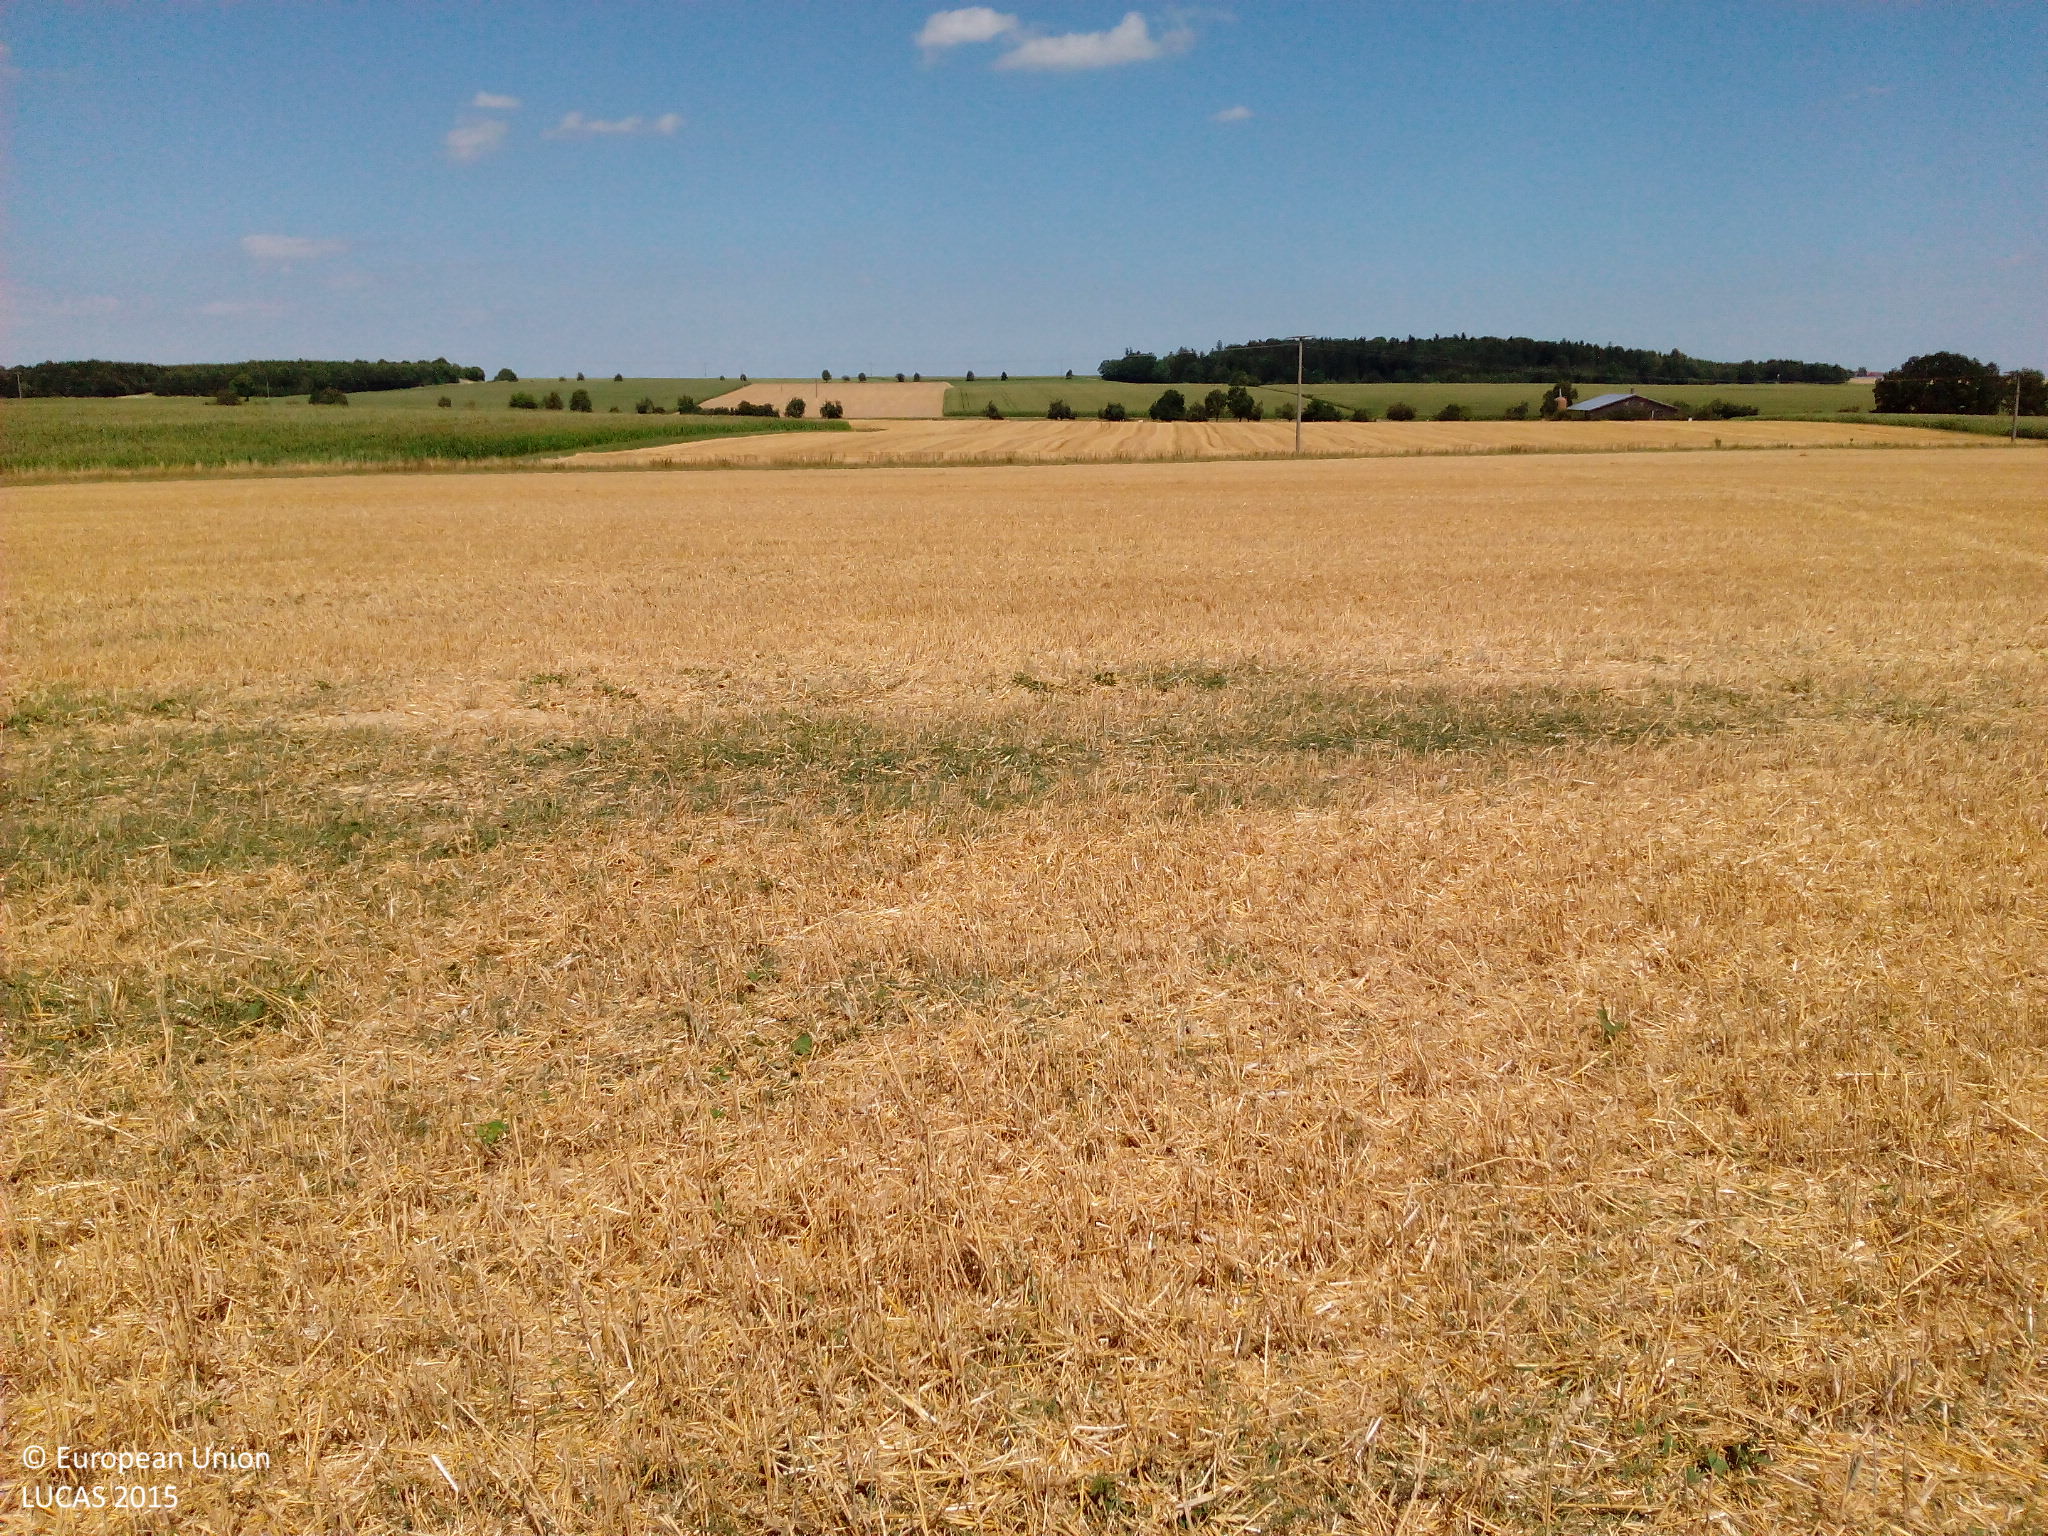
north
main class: Cropland
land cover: Common wheat
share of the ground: < 10 %
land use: Agriculture (excluding fallow land and kitchen gardens)
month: August
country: DE
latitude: 48.9788
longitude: 10.3141
